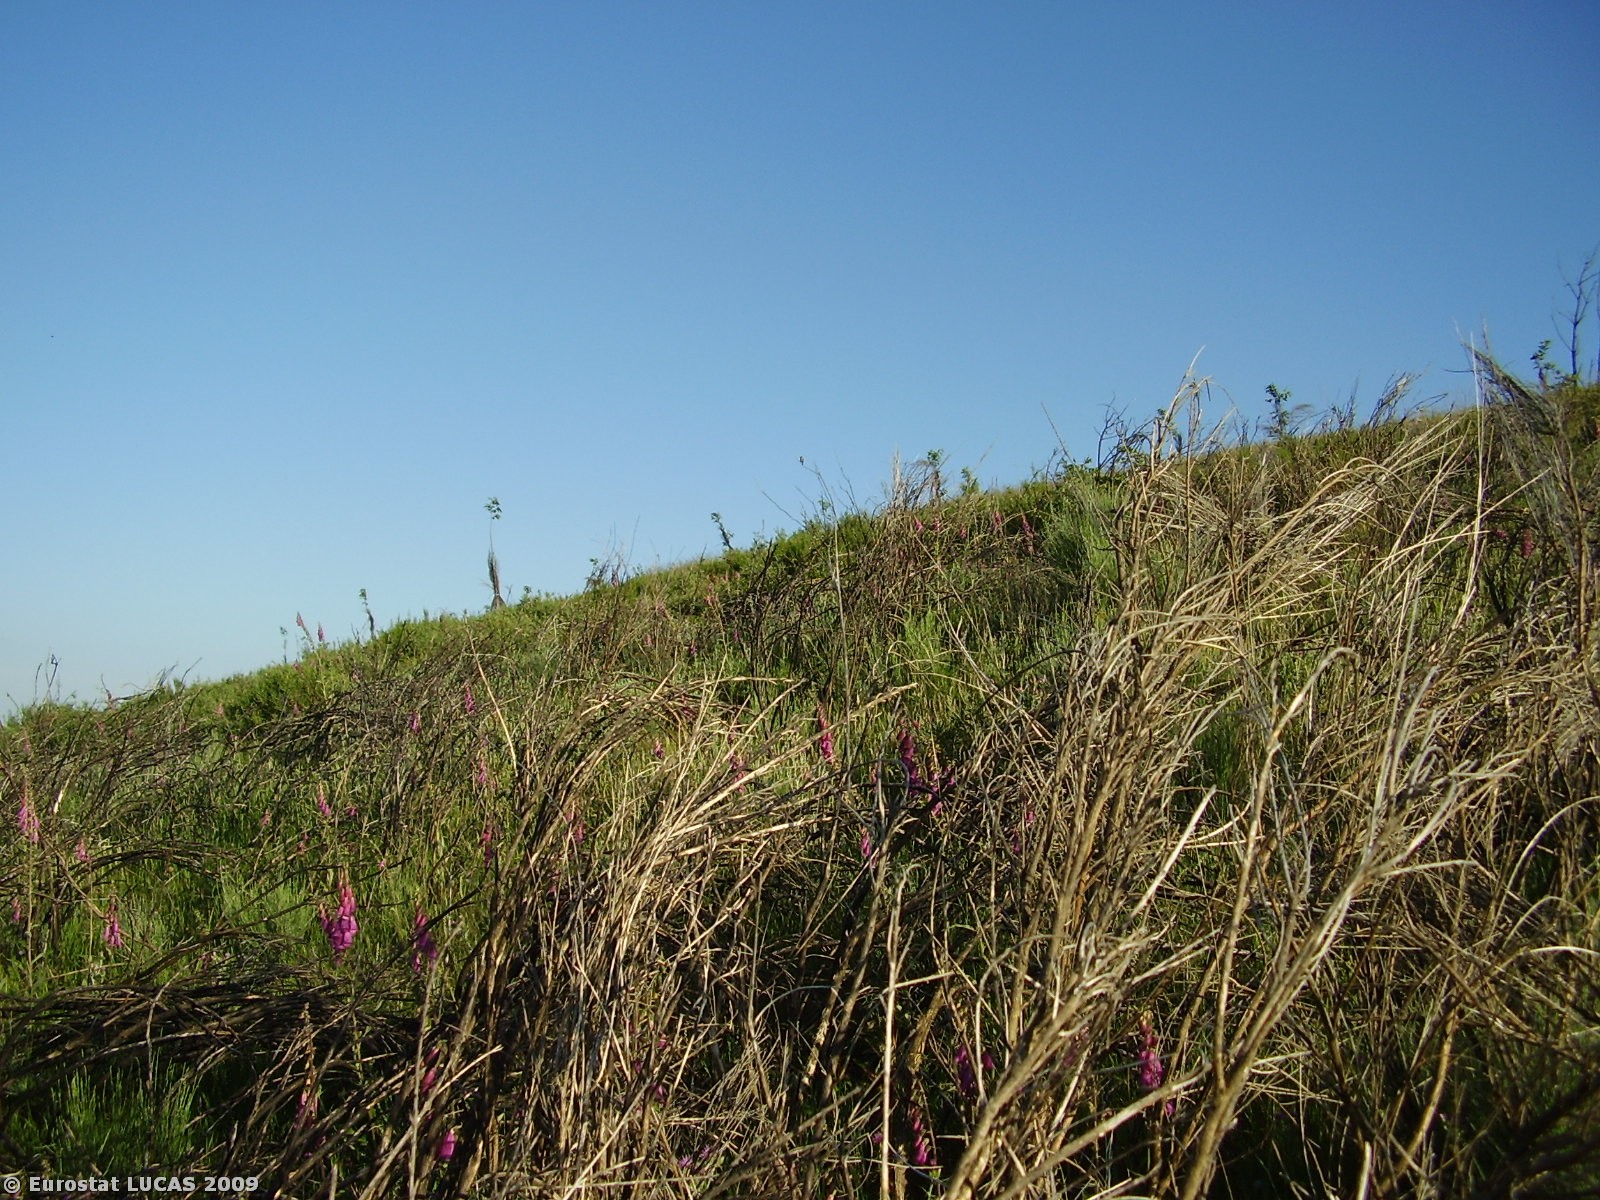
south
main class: Grassland
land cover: Spontaneously vegetated surfaces
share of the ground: > 75 %
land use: Nature reserves
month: June
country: PT
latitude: 41.9108
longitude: -6.9619
